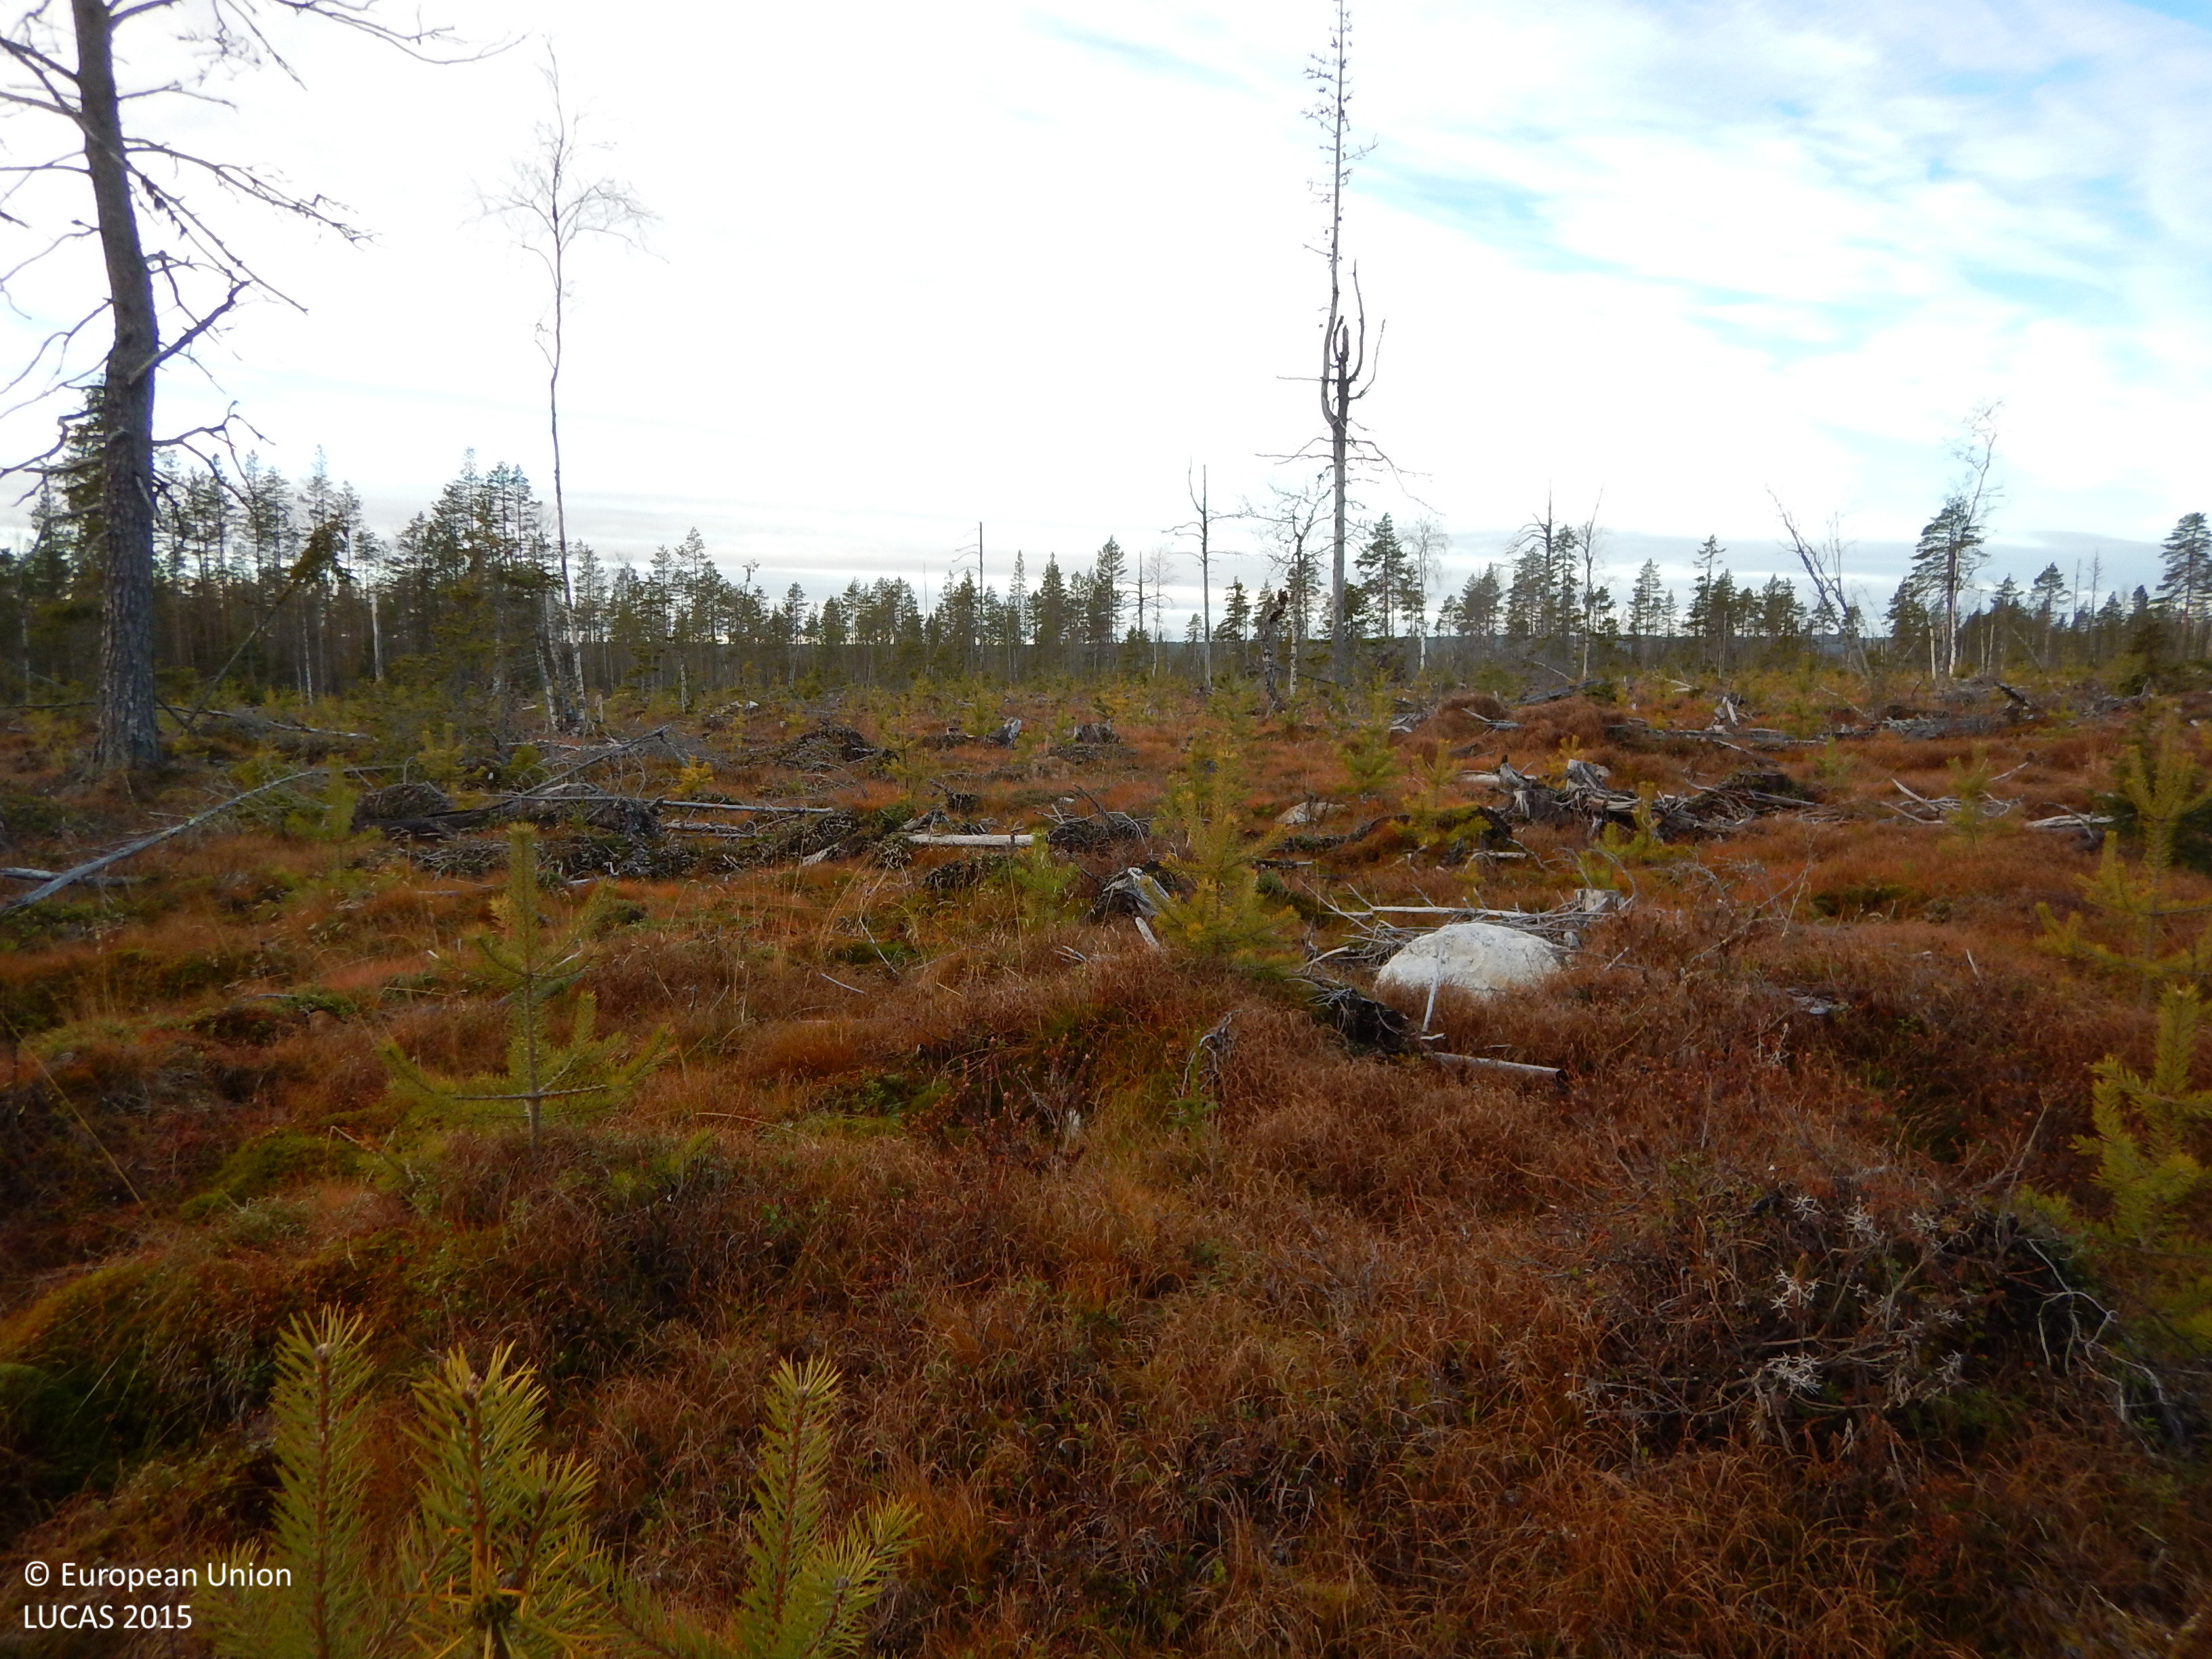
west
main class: Woodland
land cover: Pine dominated coniferous woodland
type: boreal forest
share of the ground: 25 - 50 %
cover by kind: lichens and mosses 30 %, shrubs 25 %, coniferous forest trees 20 %, herbaceous plants 20 %, broadleaved forest trees 5 %
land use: Forestry
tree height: < 5 m
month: November
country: SE
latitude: 65.3060
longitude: 20.5453
